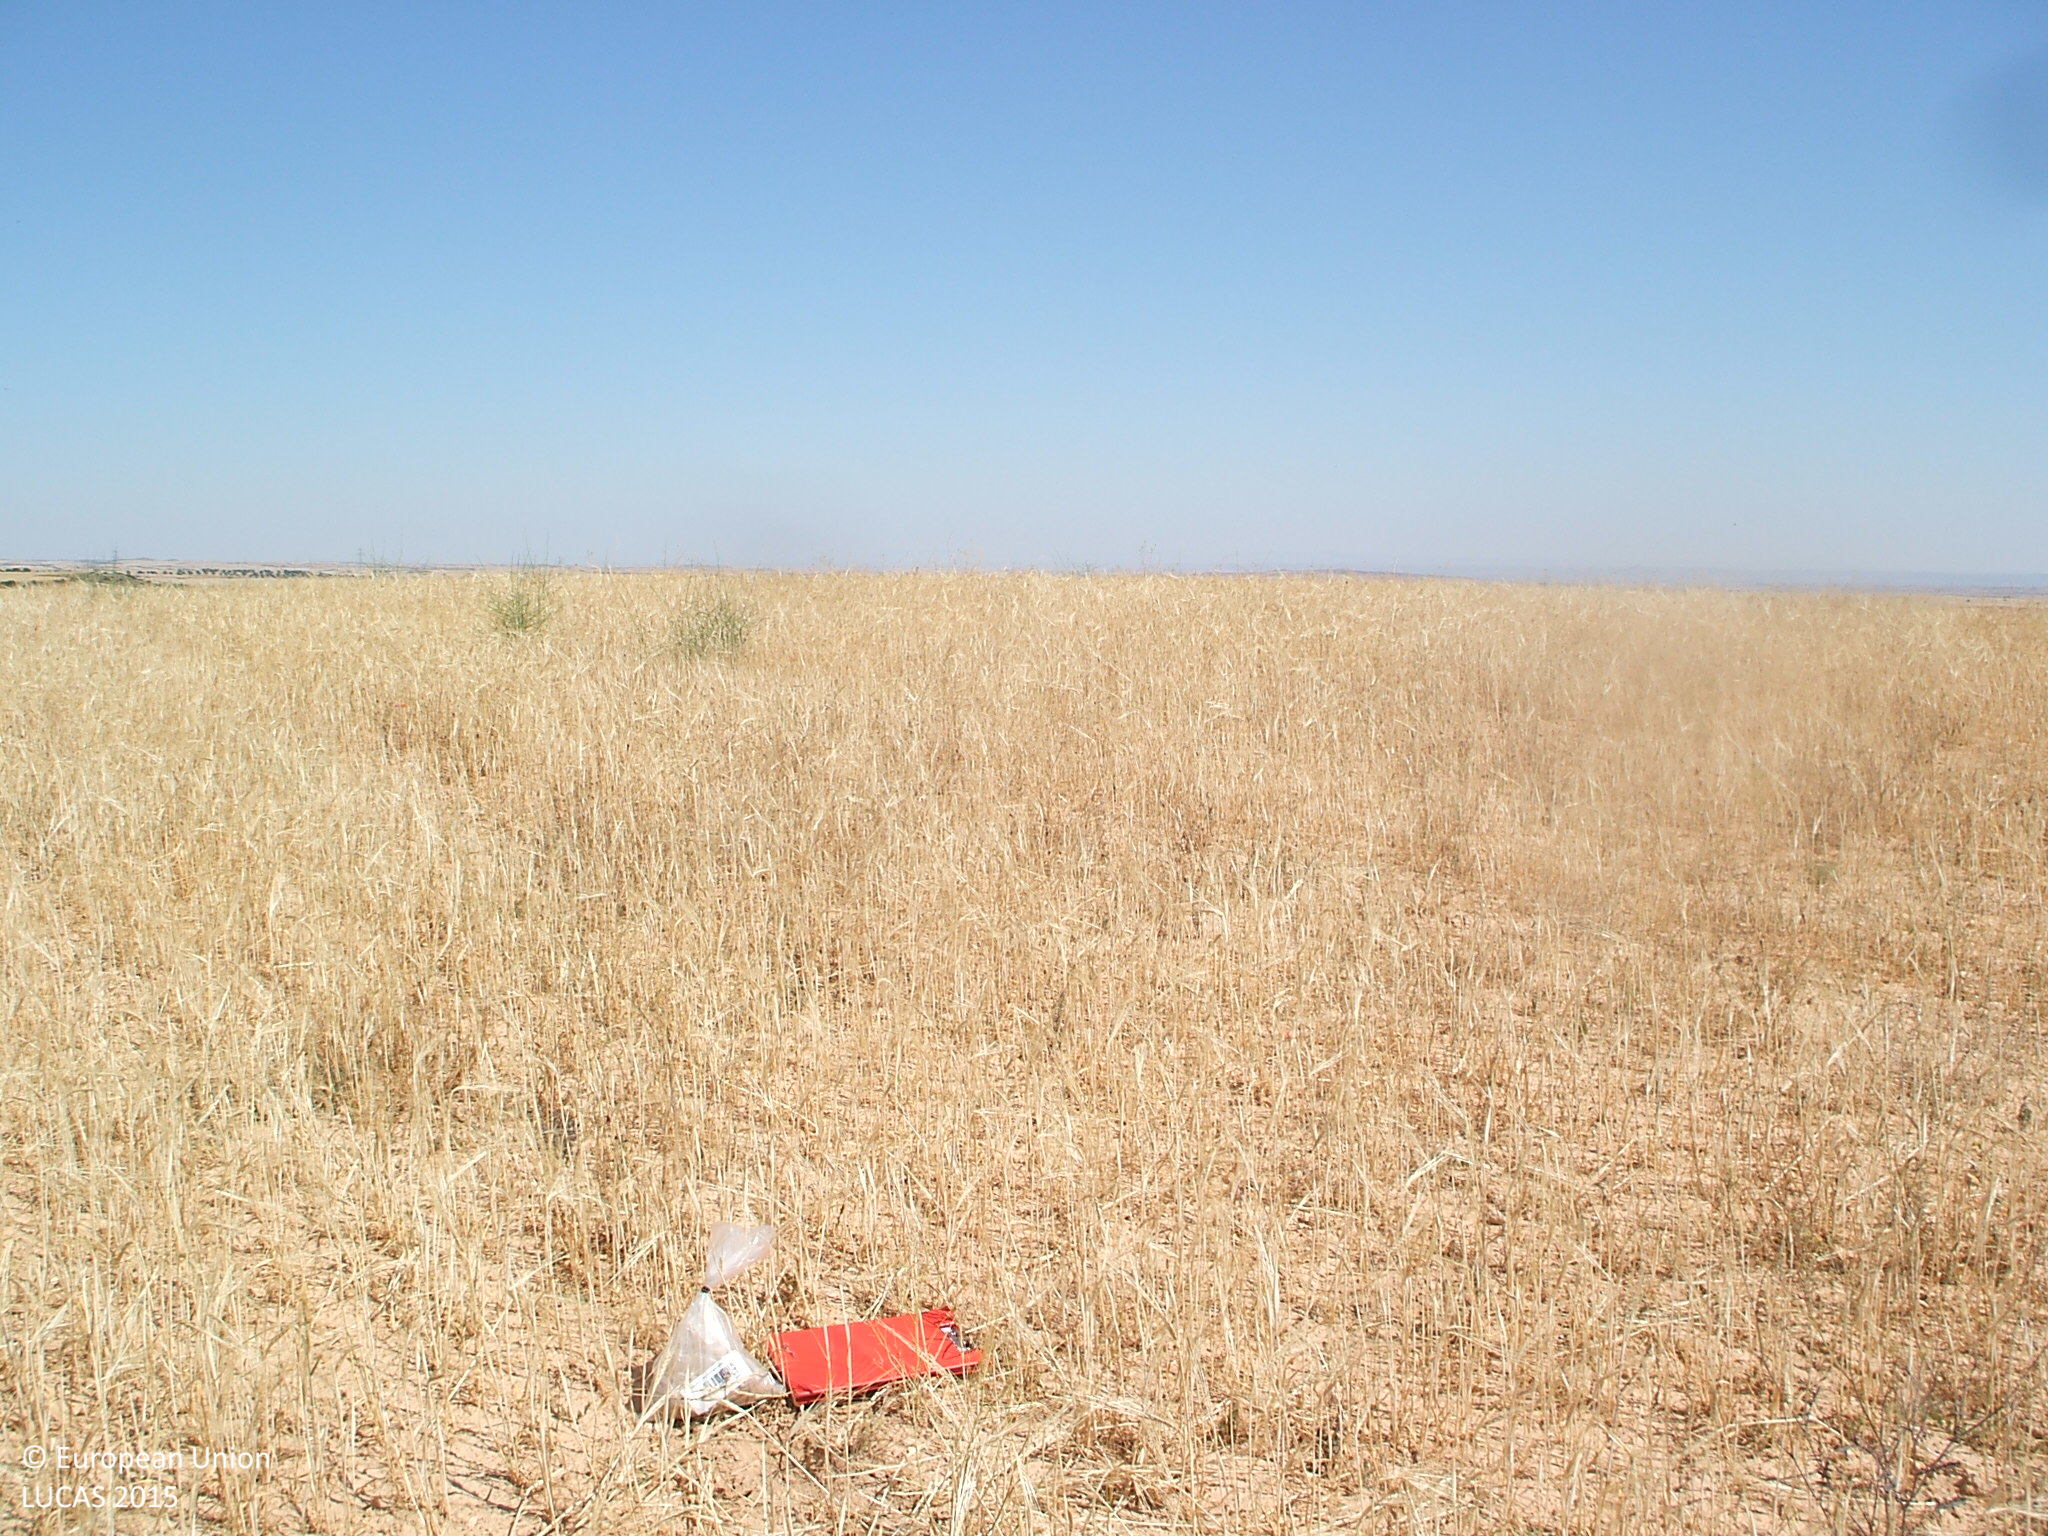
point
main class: Cropland
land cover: Barley
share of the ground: > 75 %
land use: Agriculture (excluding fallow land and kitchen gardens)
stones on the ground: > 50 %
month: June
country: ES
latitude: 41.0508
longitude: -0.3278
